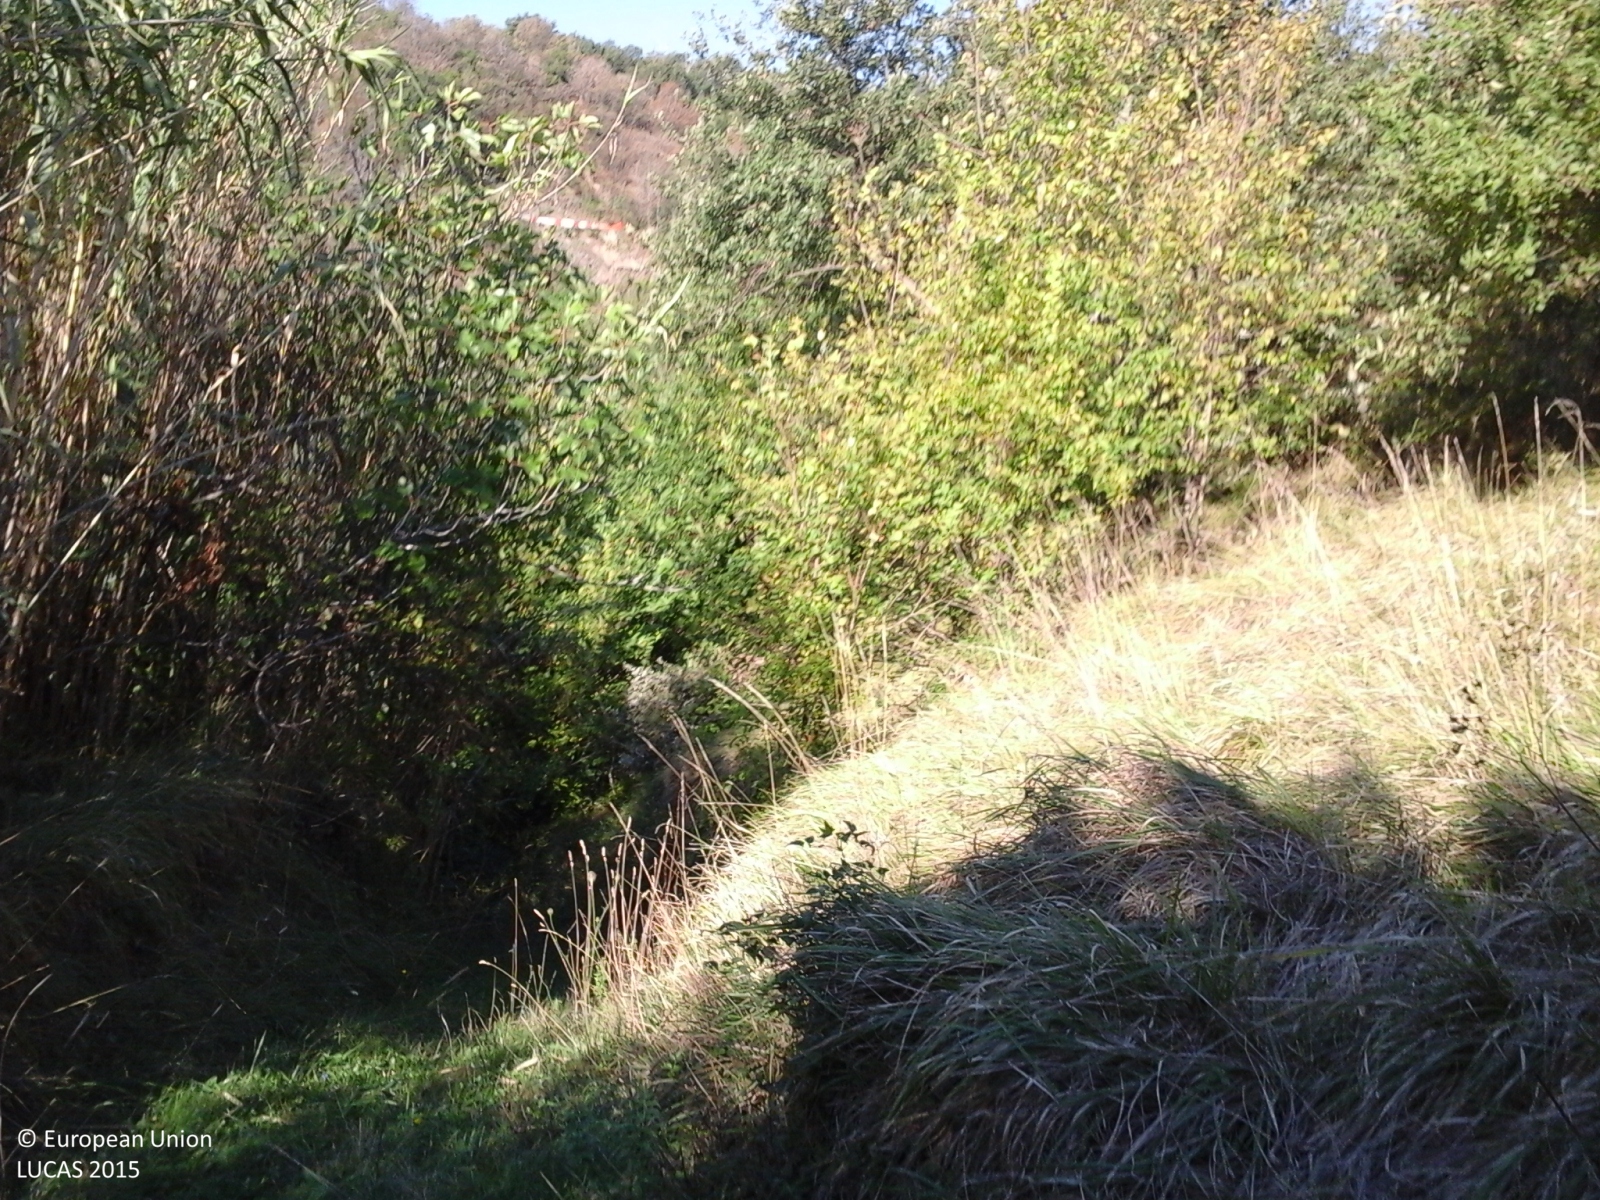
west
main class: Grassland
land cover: Grassland with sparse tree/shrub cover
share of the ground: > 75 %
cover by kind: herbaceous plants 80 %, shrubs 10 %, broadleaved forest trees 5 %, lichens and mosses 5 %
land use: Agriculture (excluding fallow land and kitchen gardens)
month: September
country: IT
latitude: 44.3936
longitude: 8.4843
